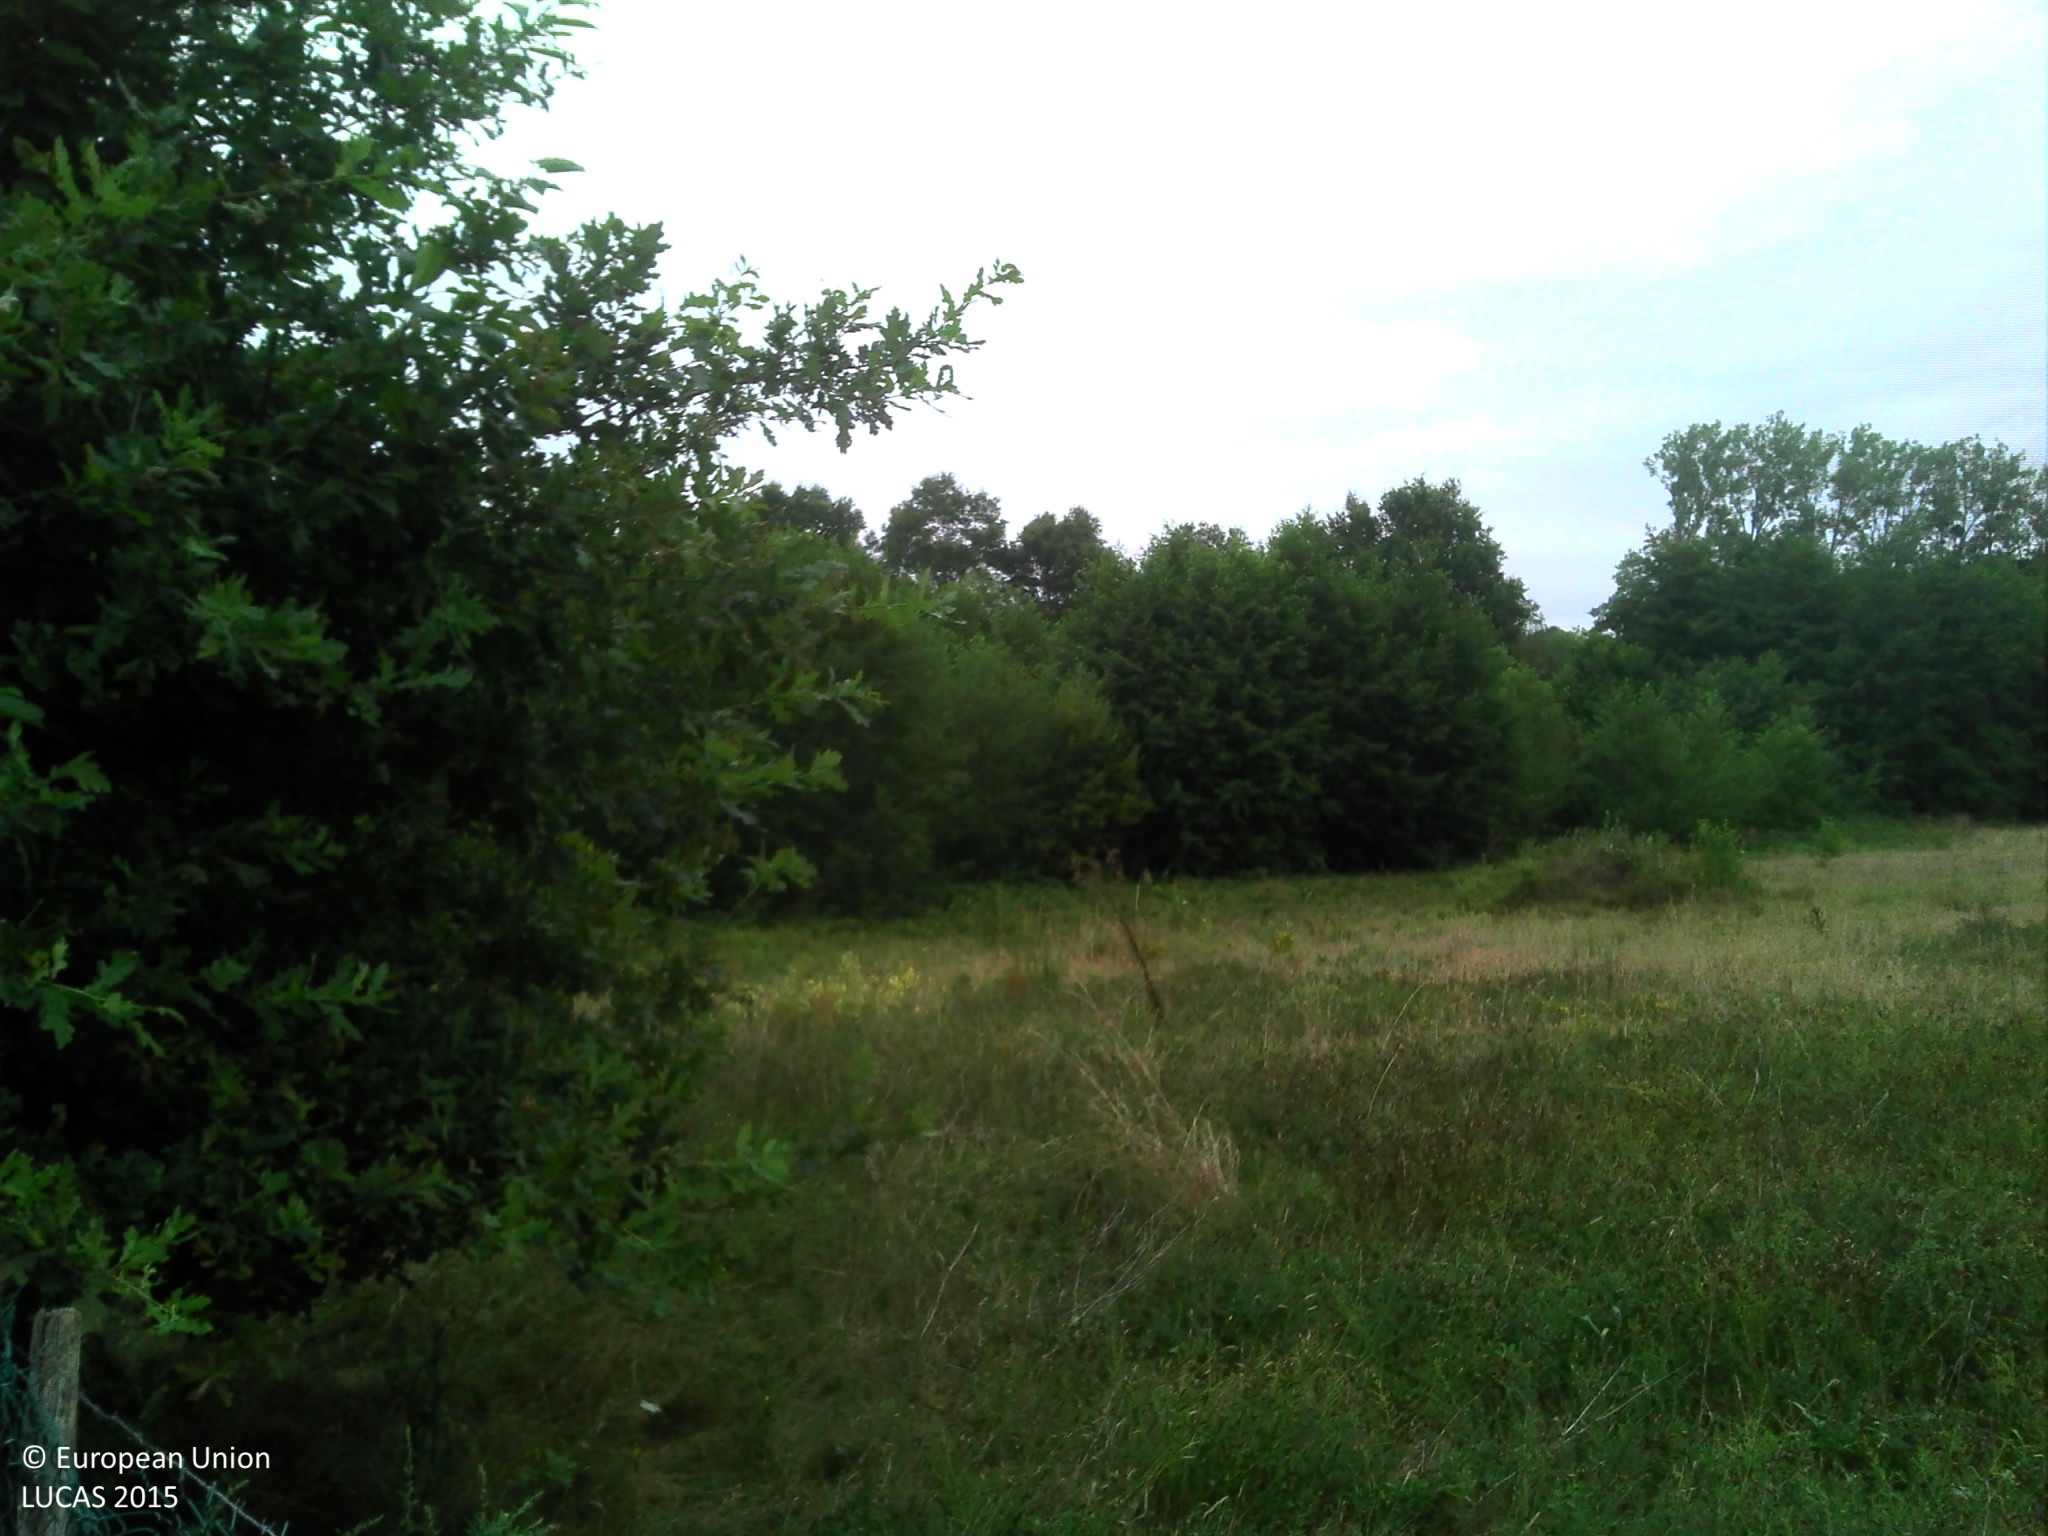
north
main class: Grassland
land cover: Spontaneously vegetated surfaces
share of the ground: > 75 %
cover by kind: herbaceous plants 100 %
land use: Abandoned areas
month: July
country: FR
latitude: 46.6731
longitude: 5.1261
